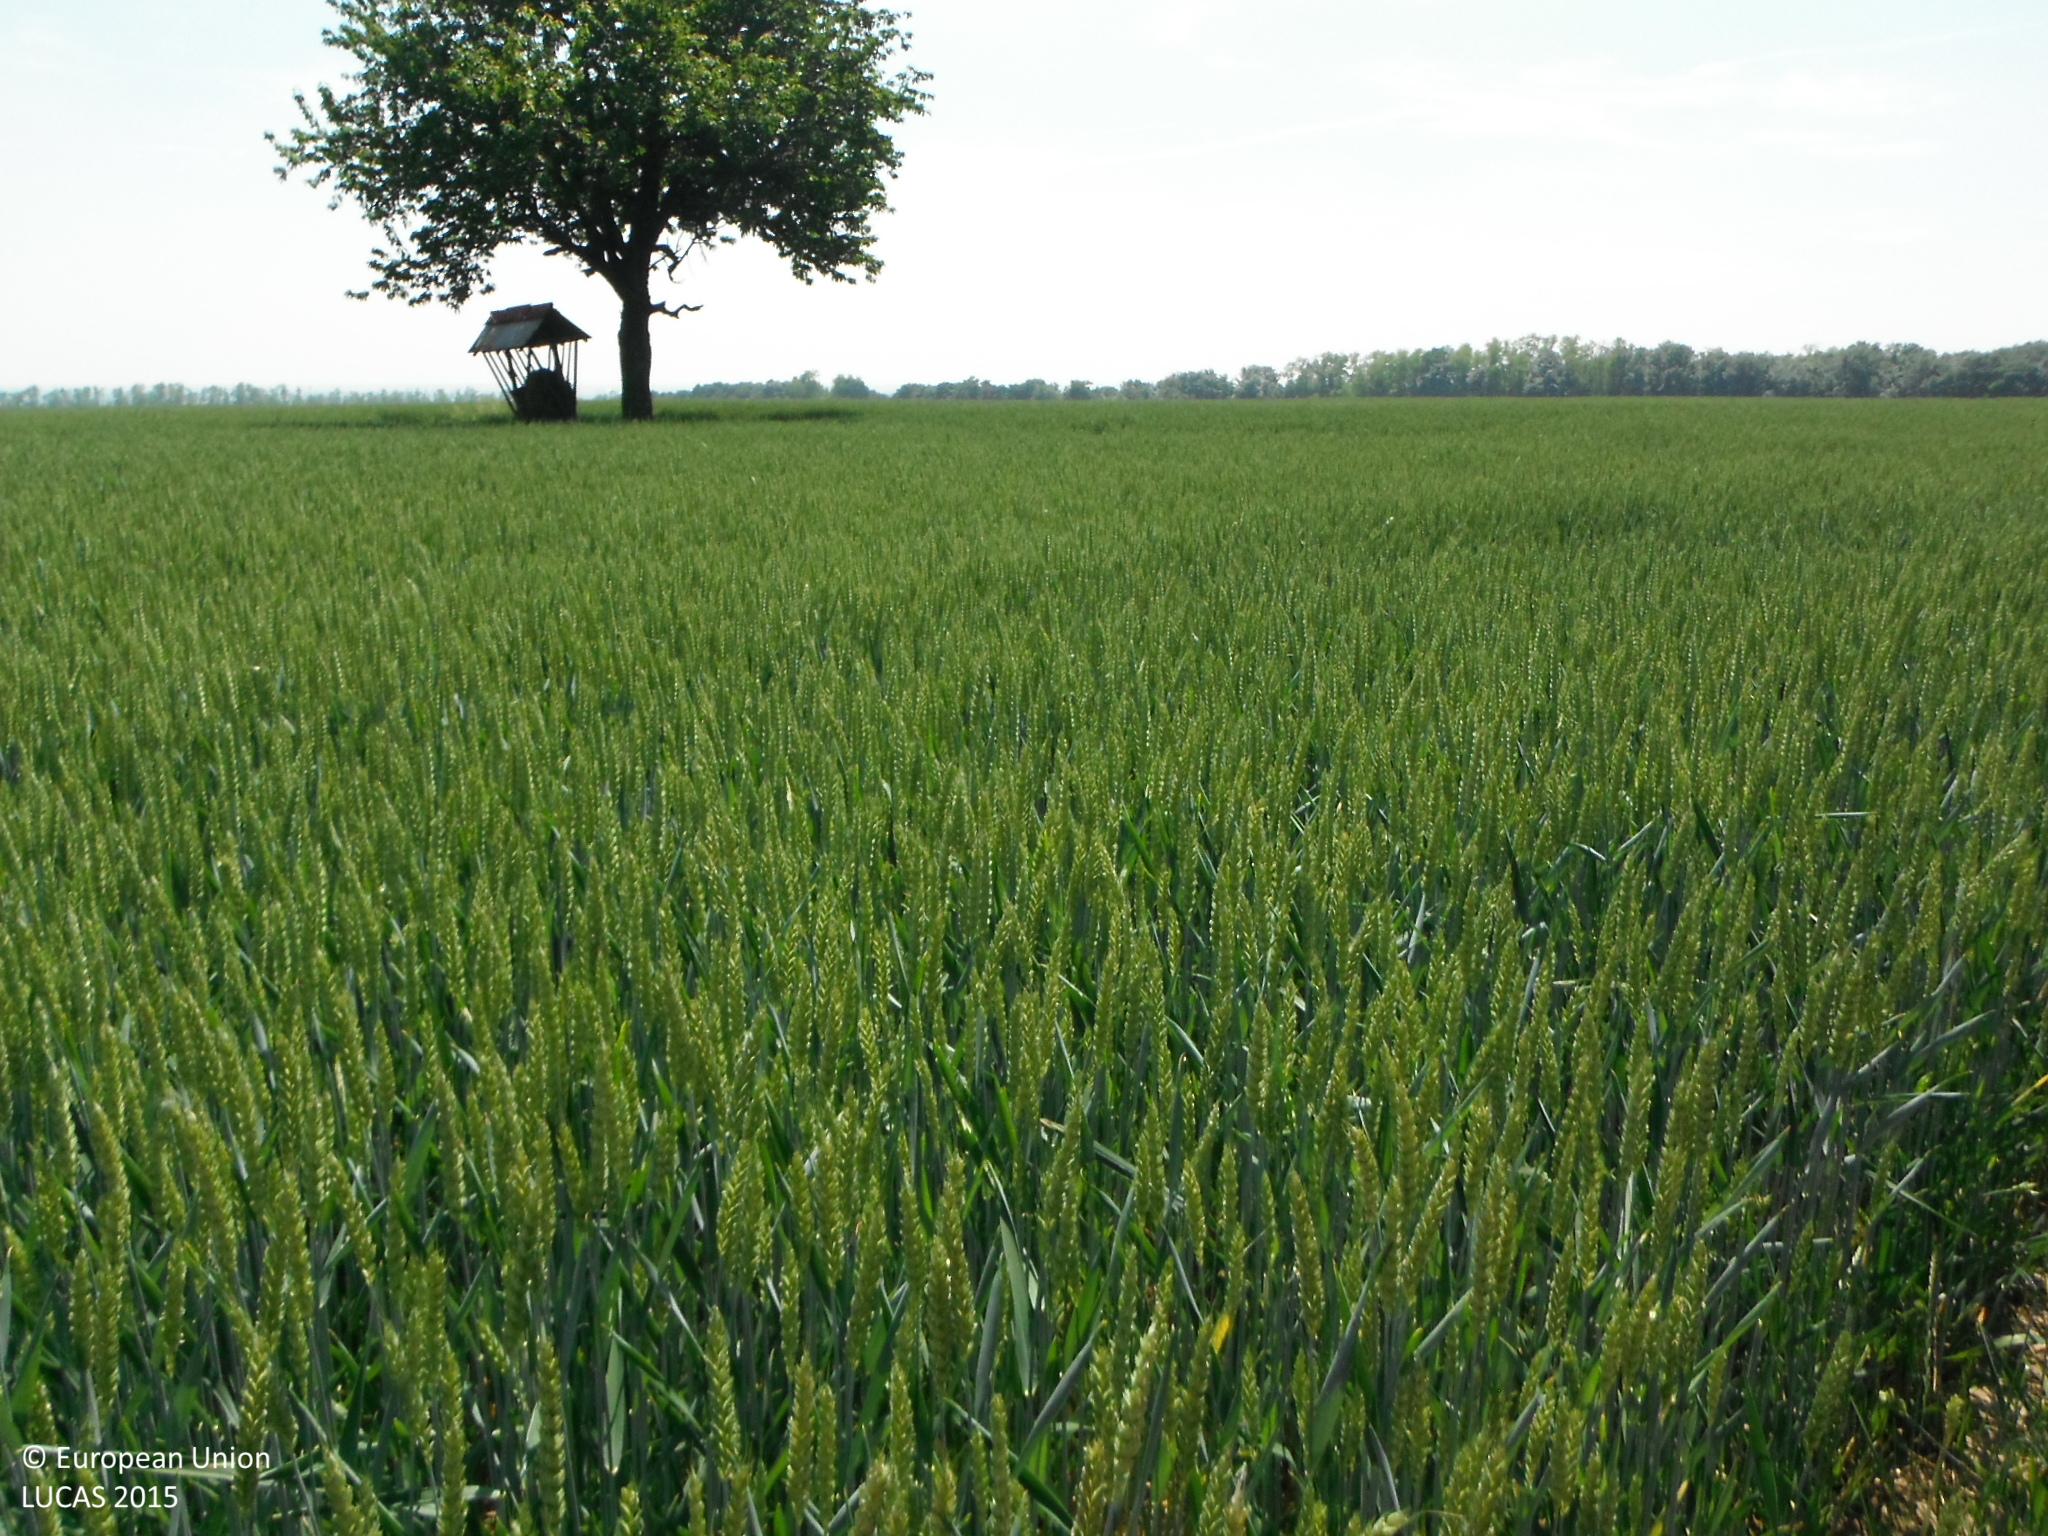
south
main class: Cropland
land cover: Common wheat
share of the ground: > 75 %
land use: Agriculture (excluding fallow land and kitchen gardens)
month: June
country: SK
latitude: 48.3171
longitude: 17.4132
